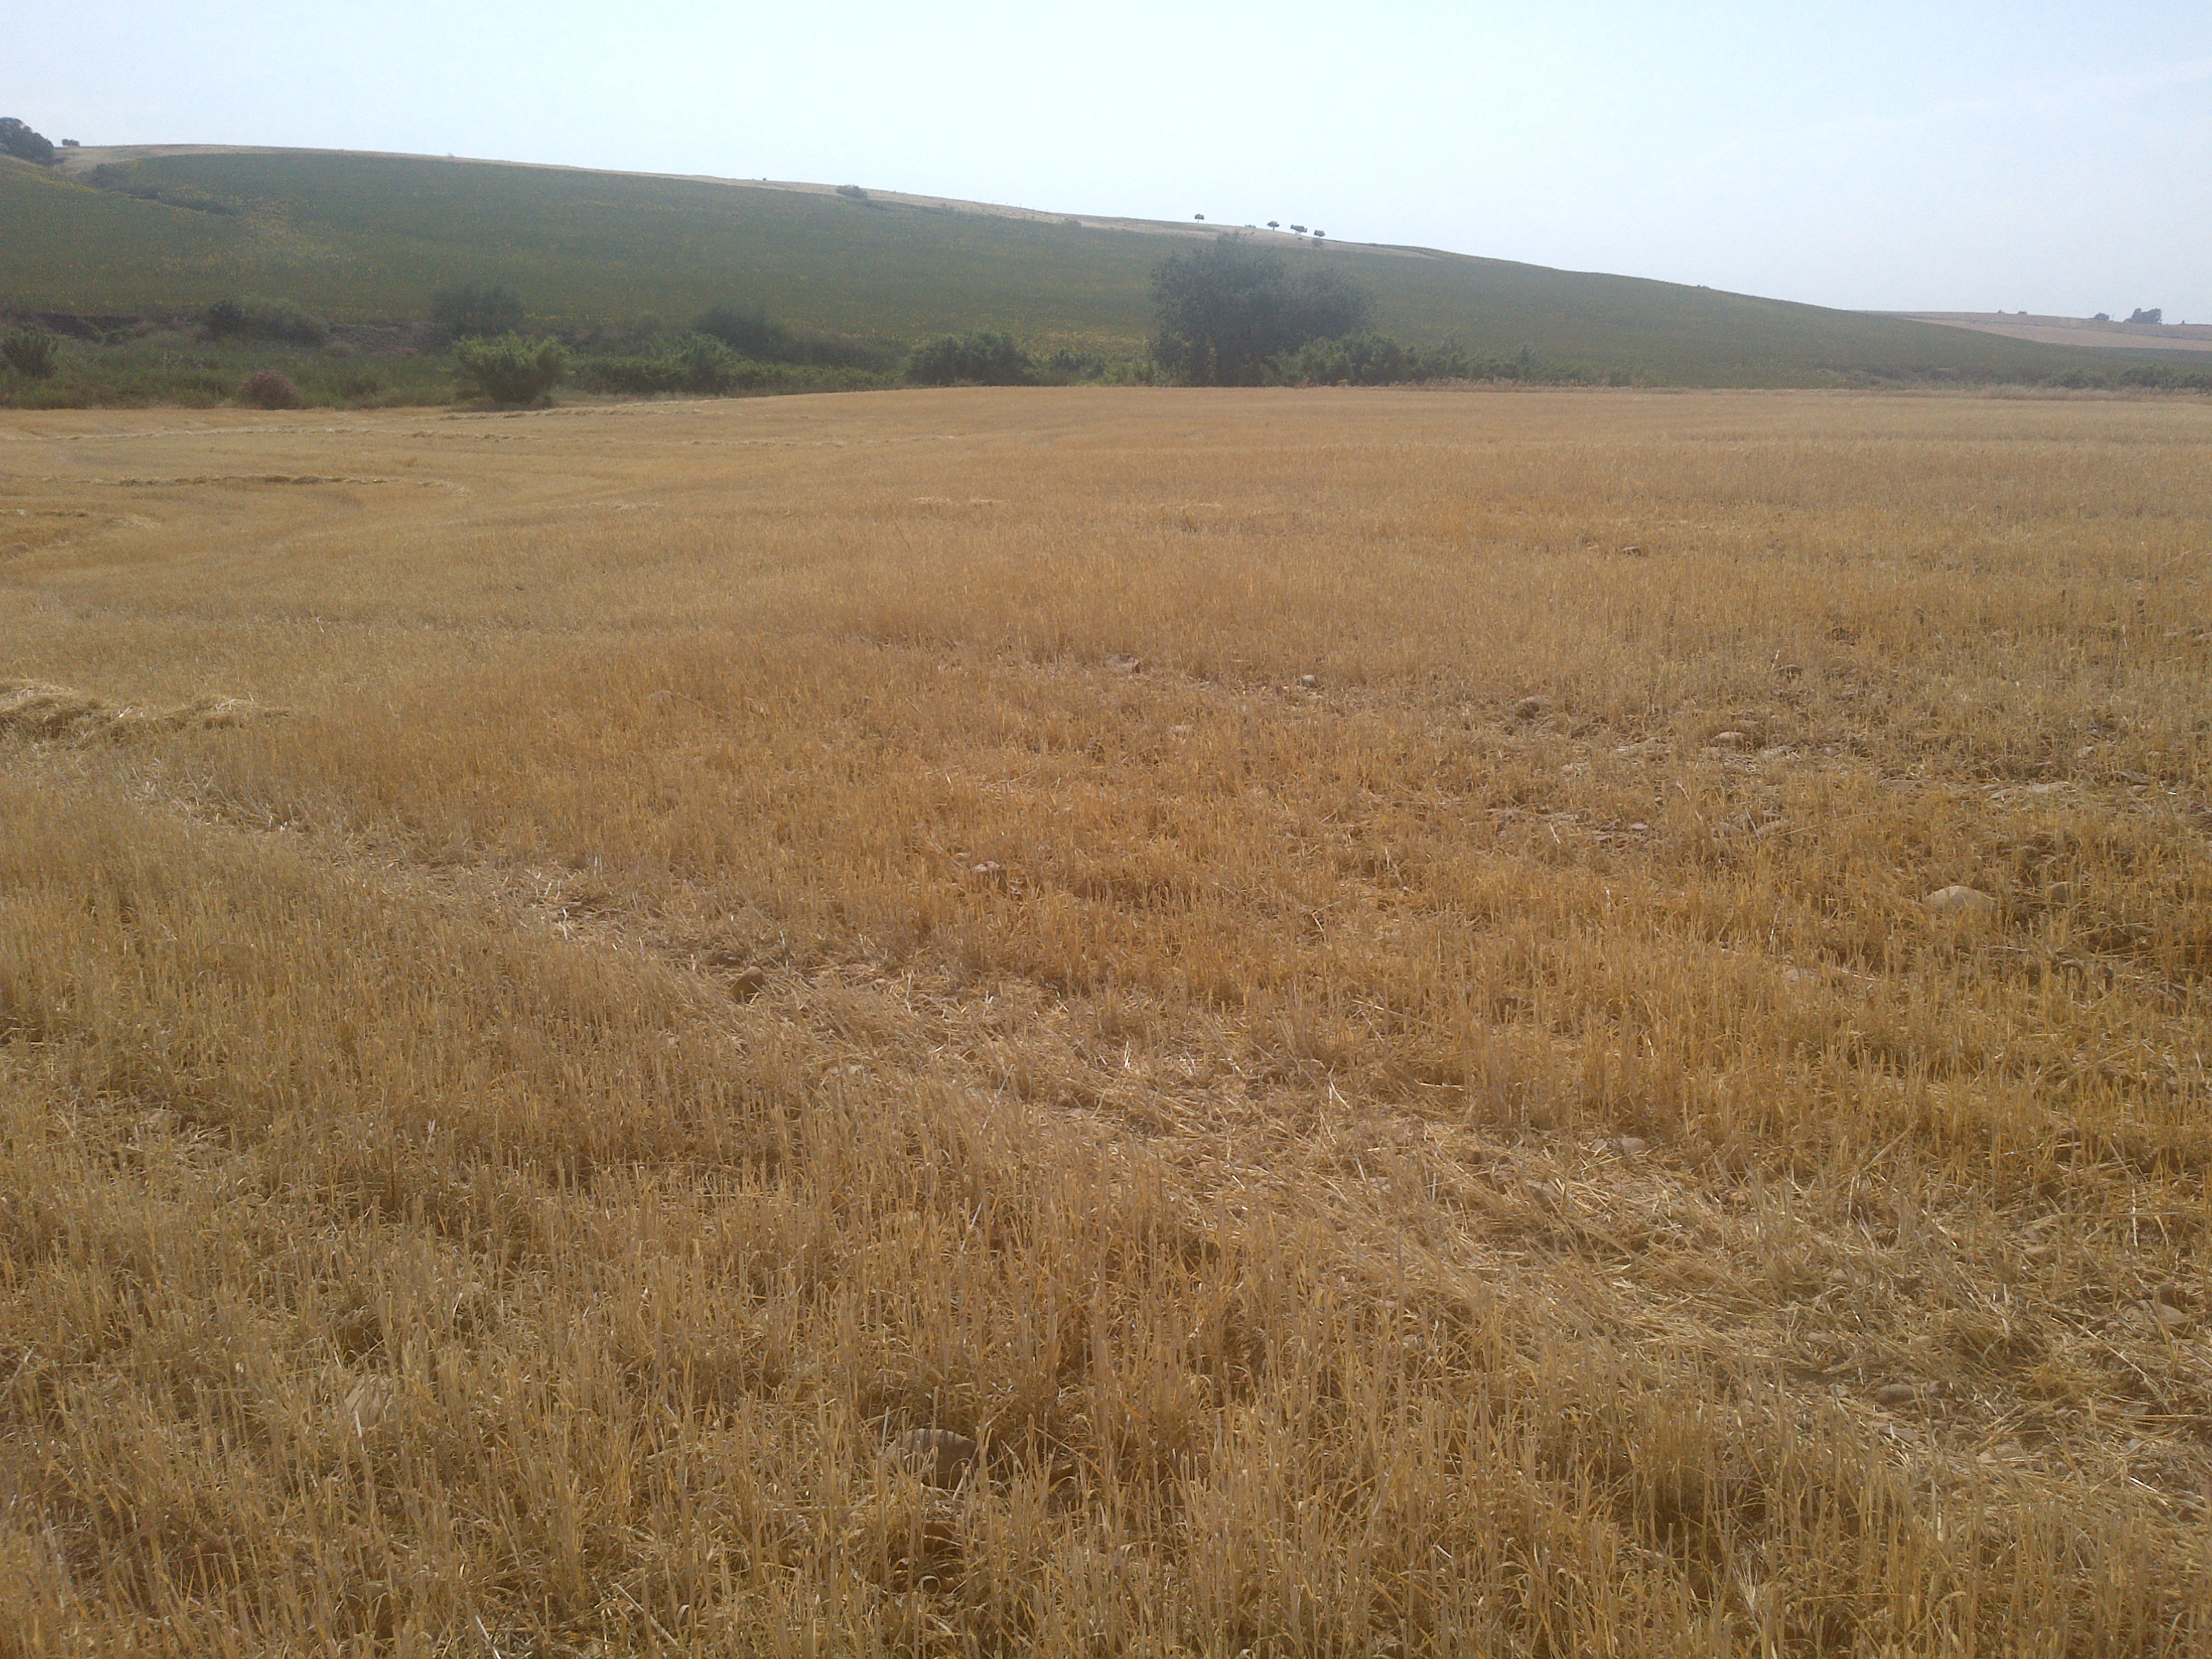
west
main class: Cropland
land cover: Durum wheat
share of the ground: < 10 %
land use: Agriculture (excluding fallow land and kitchen gardens)
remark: Harvested field
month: June
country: ES
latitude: 37.7383
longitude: -4.9363
